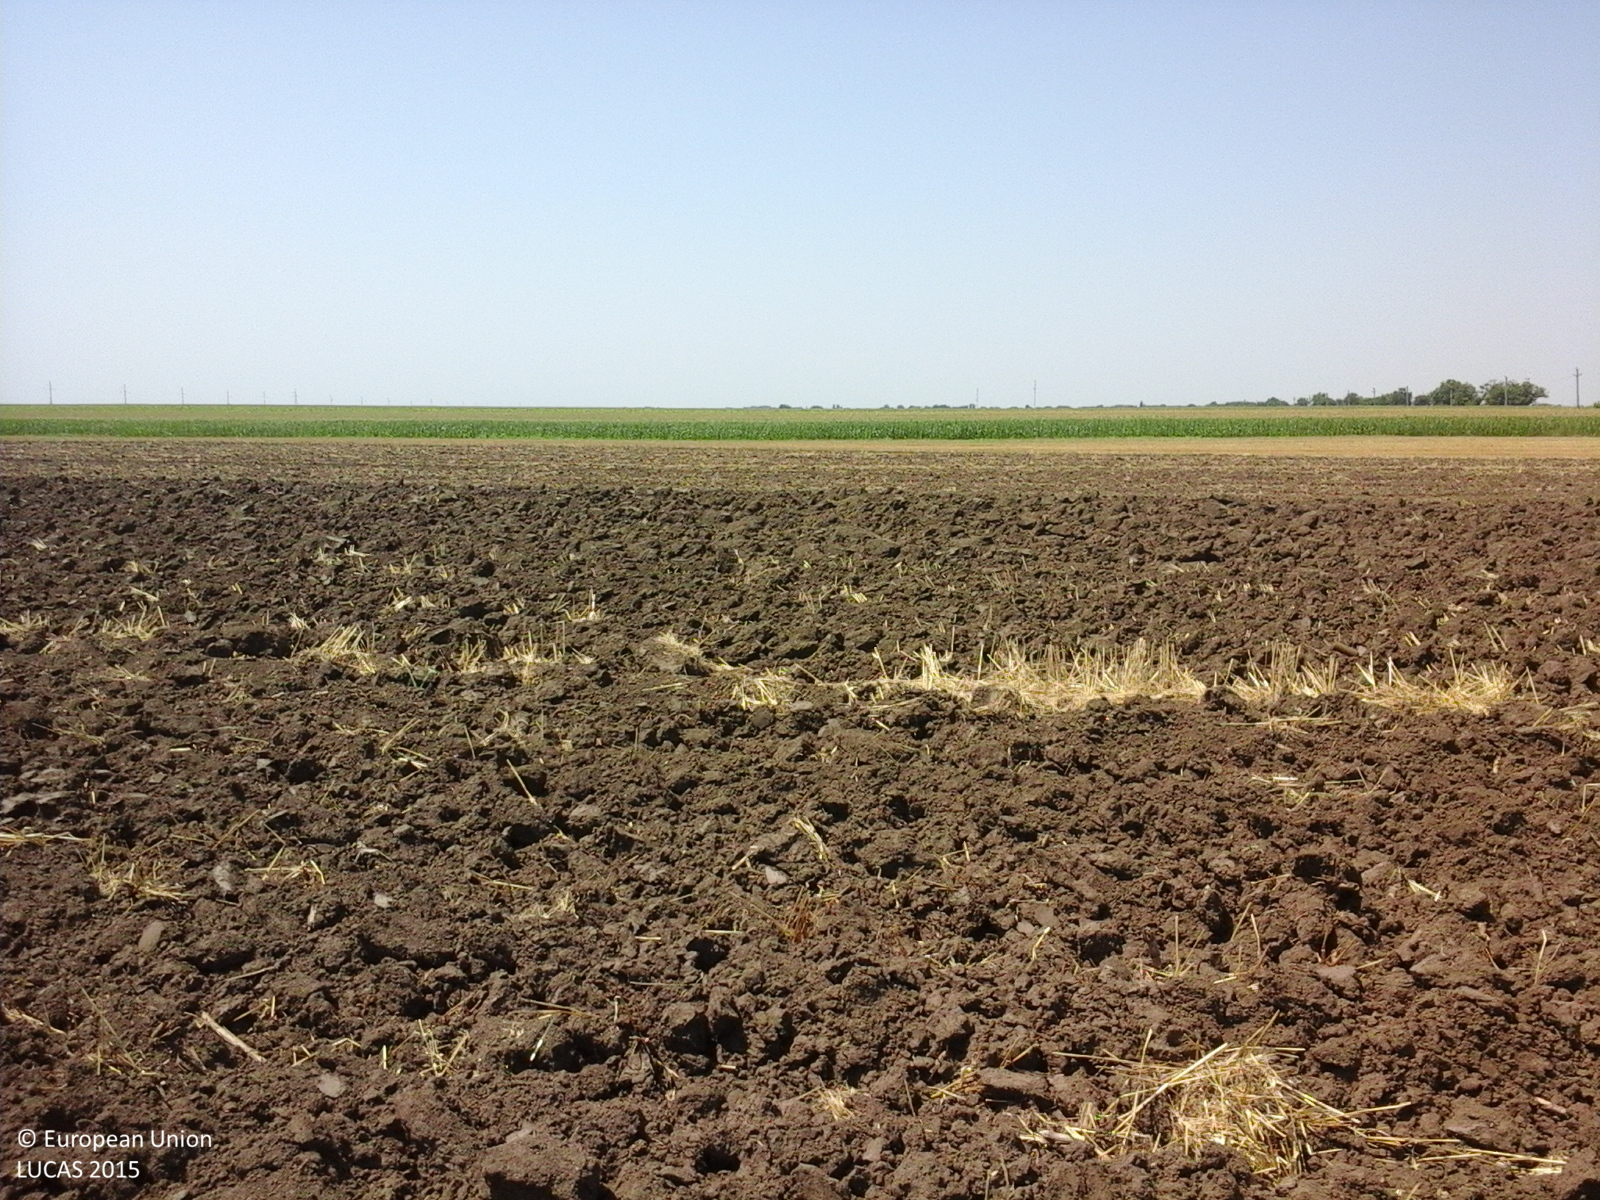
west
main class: Cropland
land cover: Common wheat
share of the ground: < 10 %
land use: Agriculture (excluding fallow land and kitchen gardens)
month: July
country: RO
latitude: 44.5015
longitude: 26.7623
